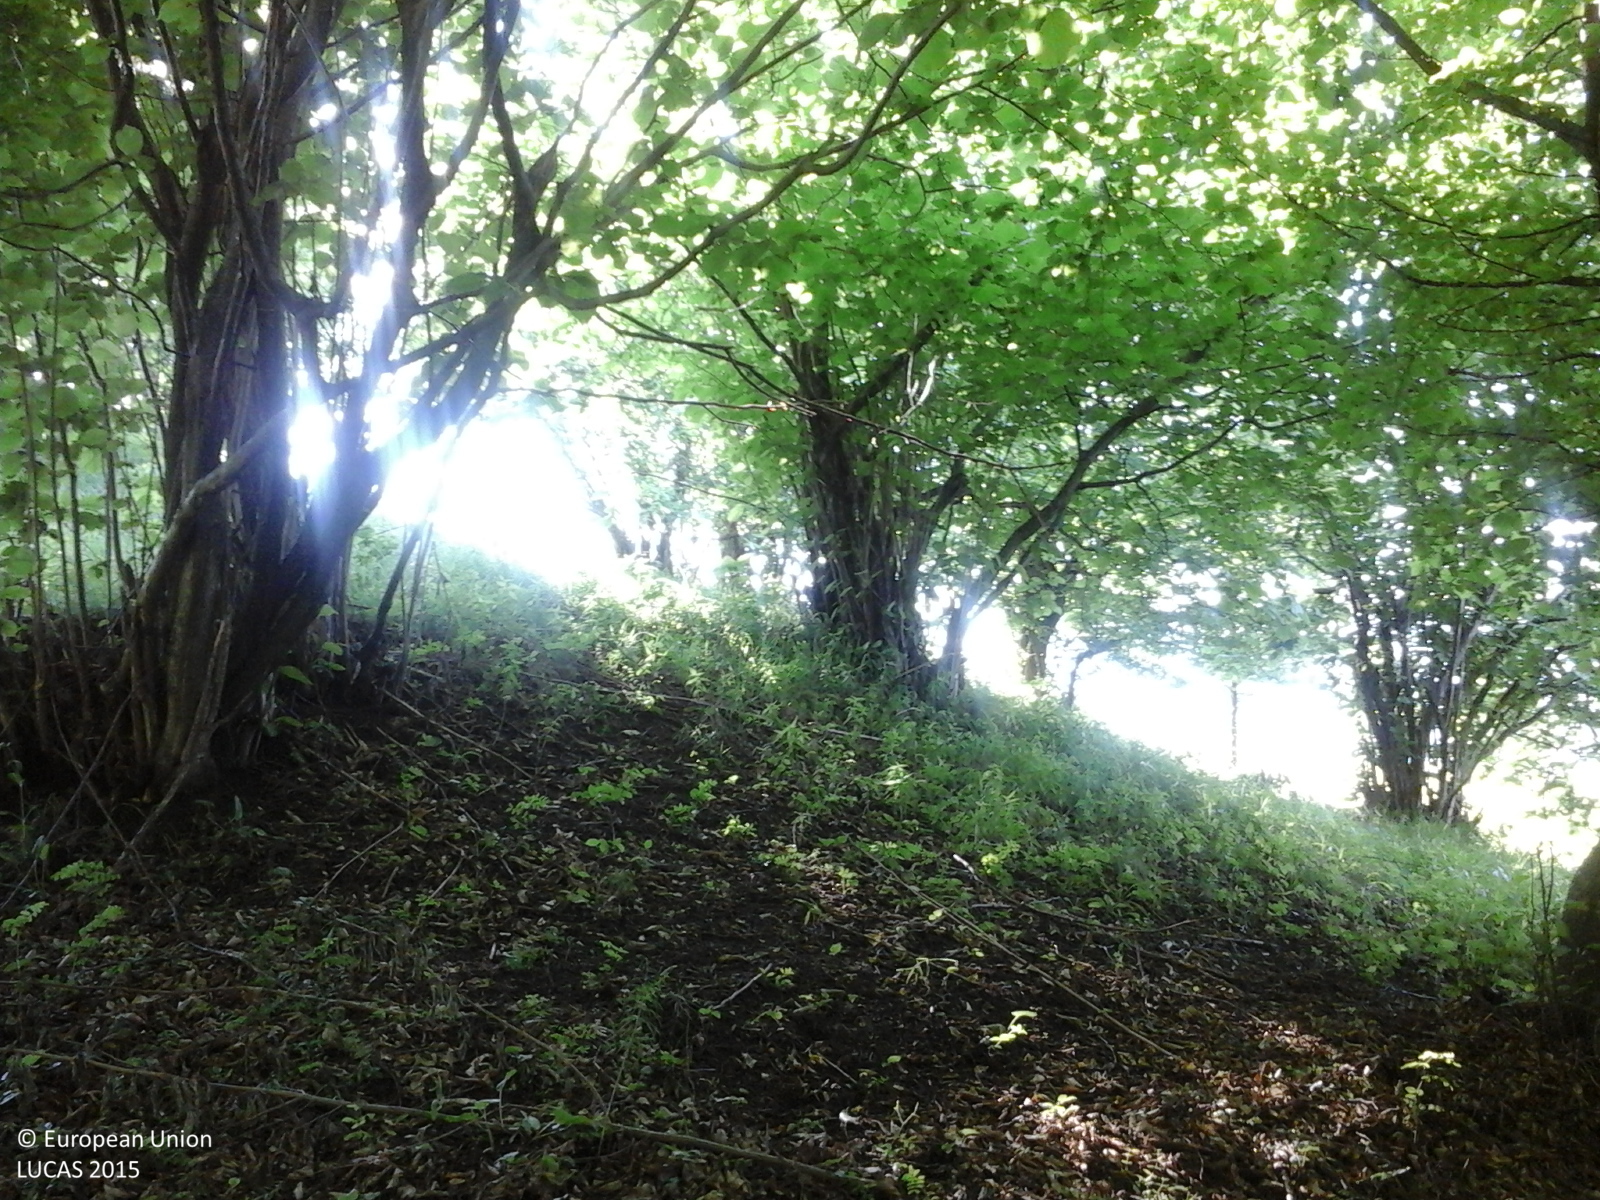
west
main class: Woodland
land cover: Broadleaved woodland
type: beech forest
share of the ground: > 75 %
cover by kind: broadleaved forest trees 100 %
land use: Forestry
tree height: > 5 m
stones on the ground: < 10 %
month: May
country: RO
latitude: 45.3079
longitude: 26.1992
